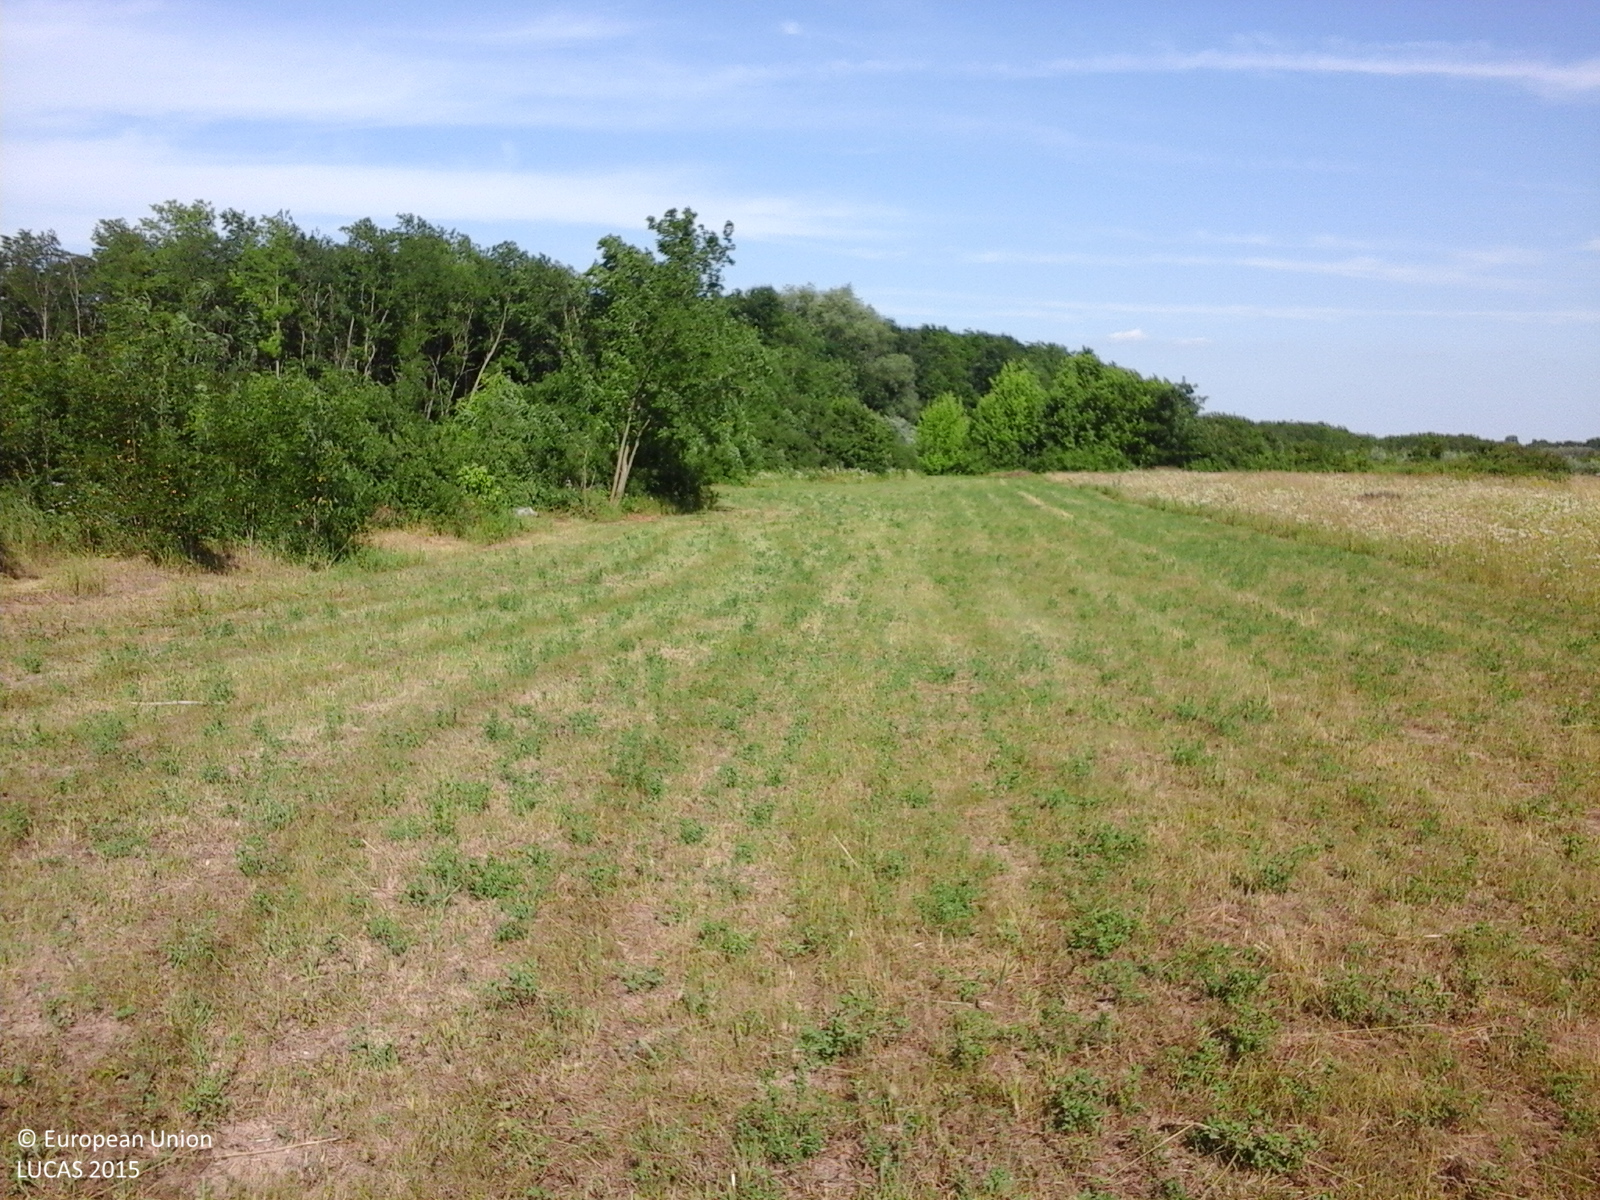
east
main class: Cropland
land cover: Other leguminous and mixtures for fodder
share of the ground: 25 - 50 %
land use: Agriculture (excluding fallow land and kitchen gardens)
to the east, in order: Other leguminous and mixtures for fodder; Broadleaved woodland
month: June
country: RO
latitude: 48.2471
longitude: 26.7871
